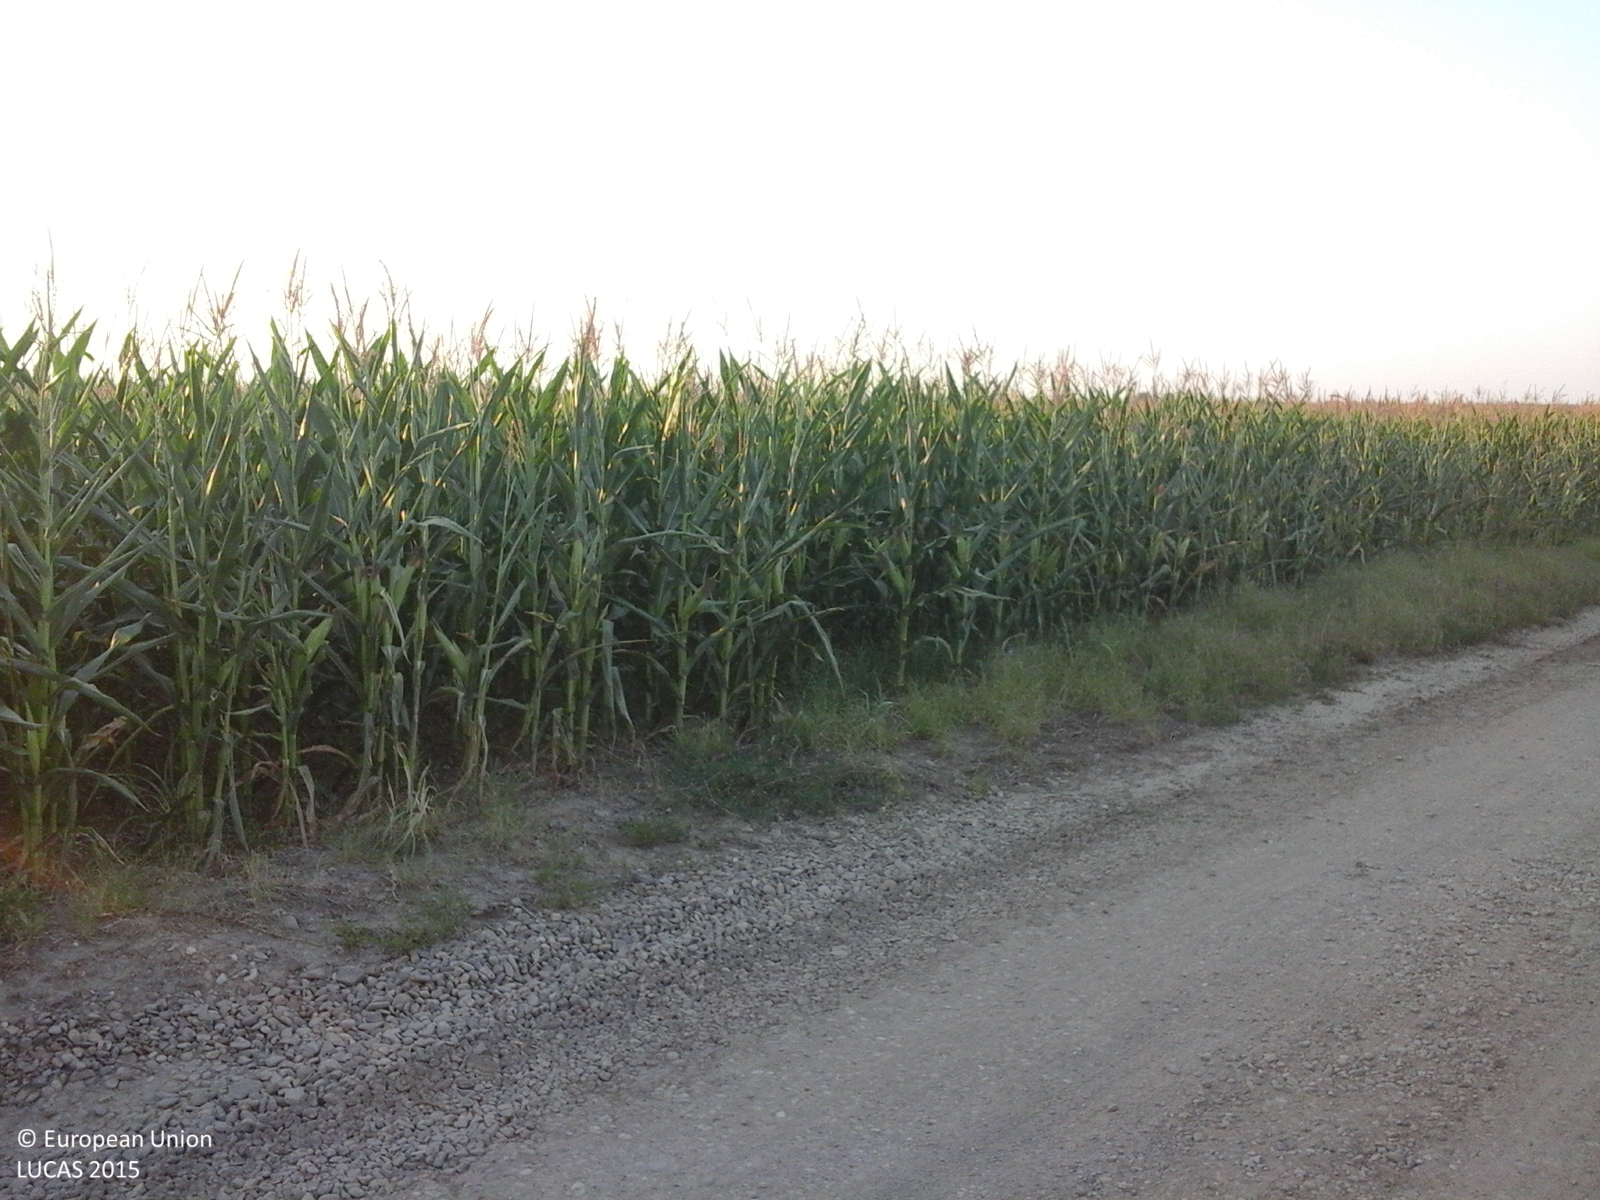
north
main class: Cropland
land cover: Maize
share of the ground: > 75 %
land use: Agriculture (excluding fallow land and kitchen gardens)
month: July
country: RO
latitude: 45.0968
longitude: 26.9453
